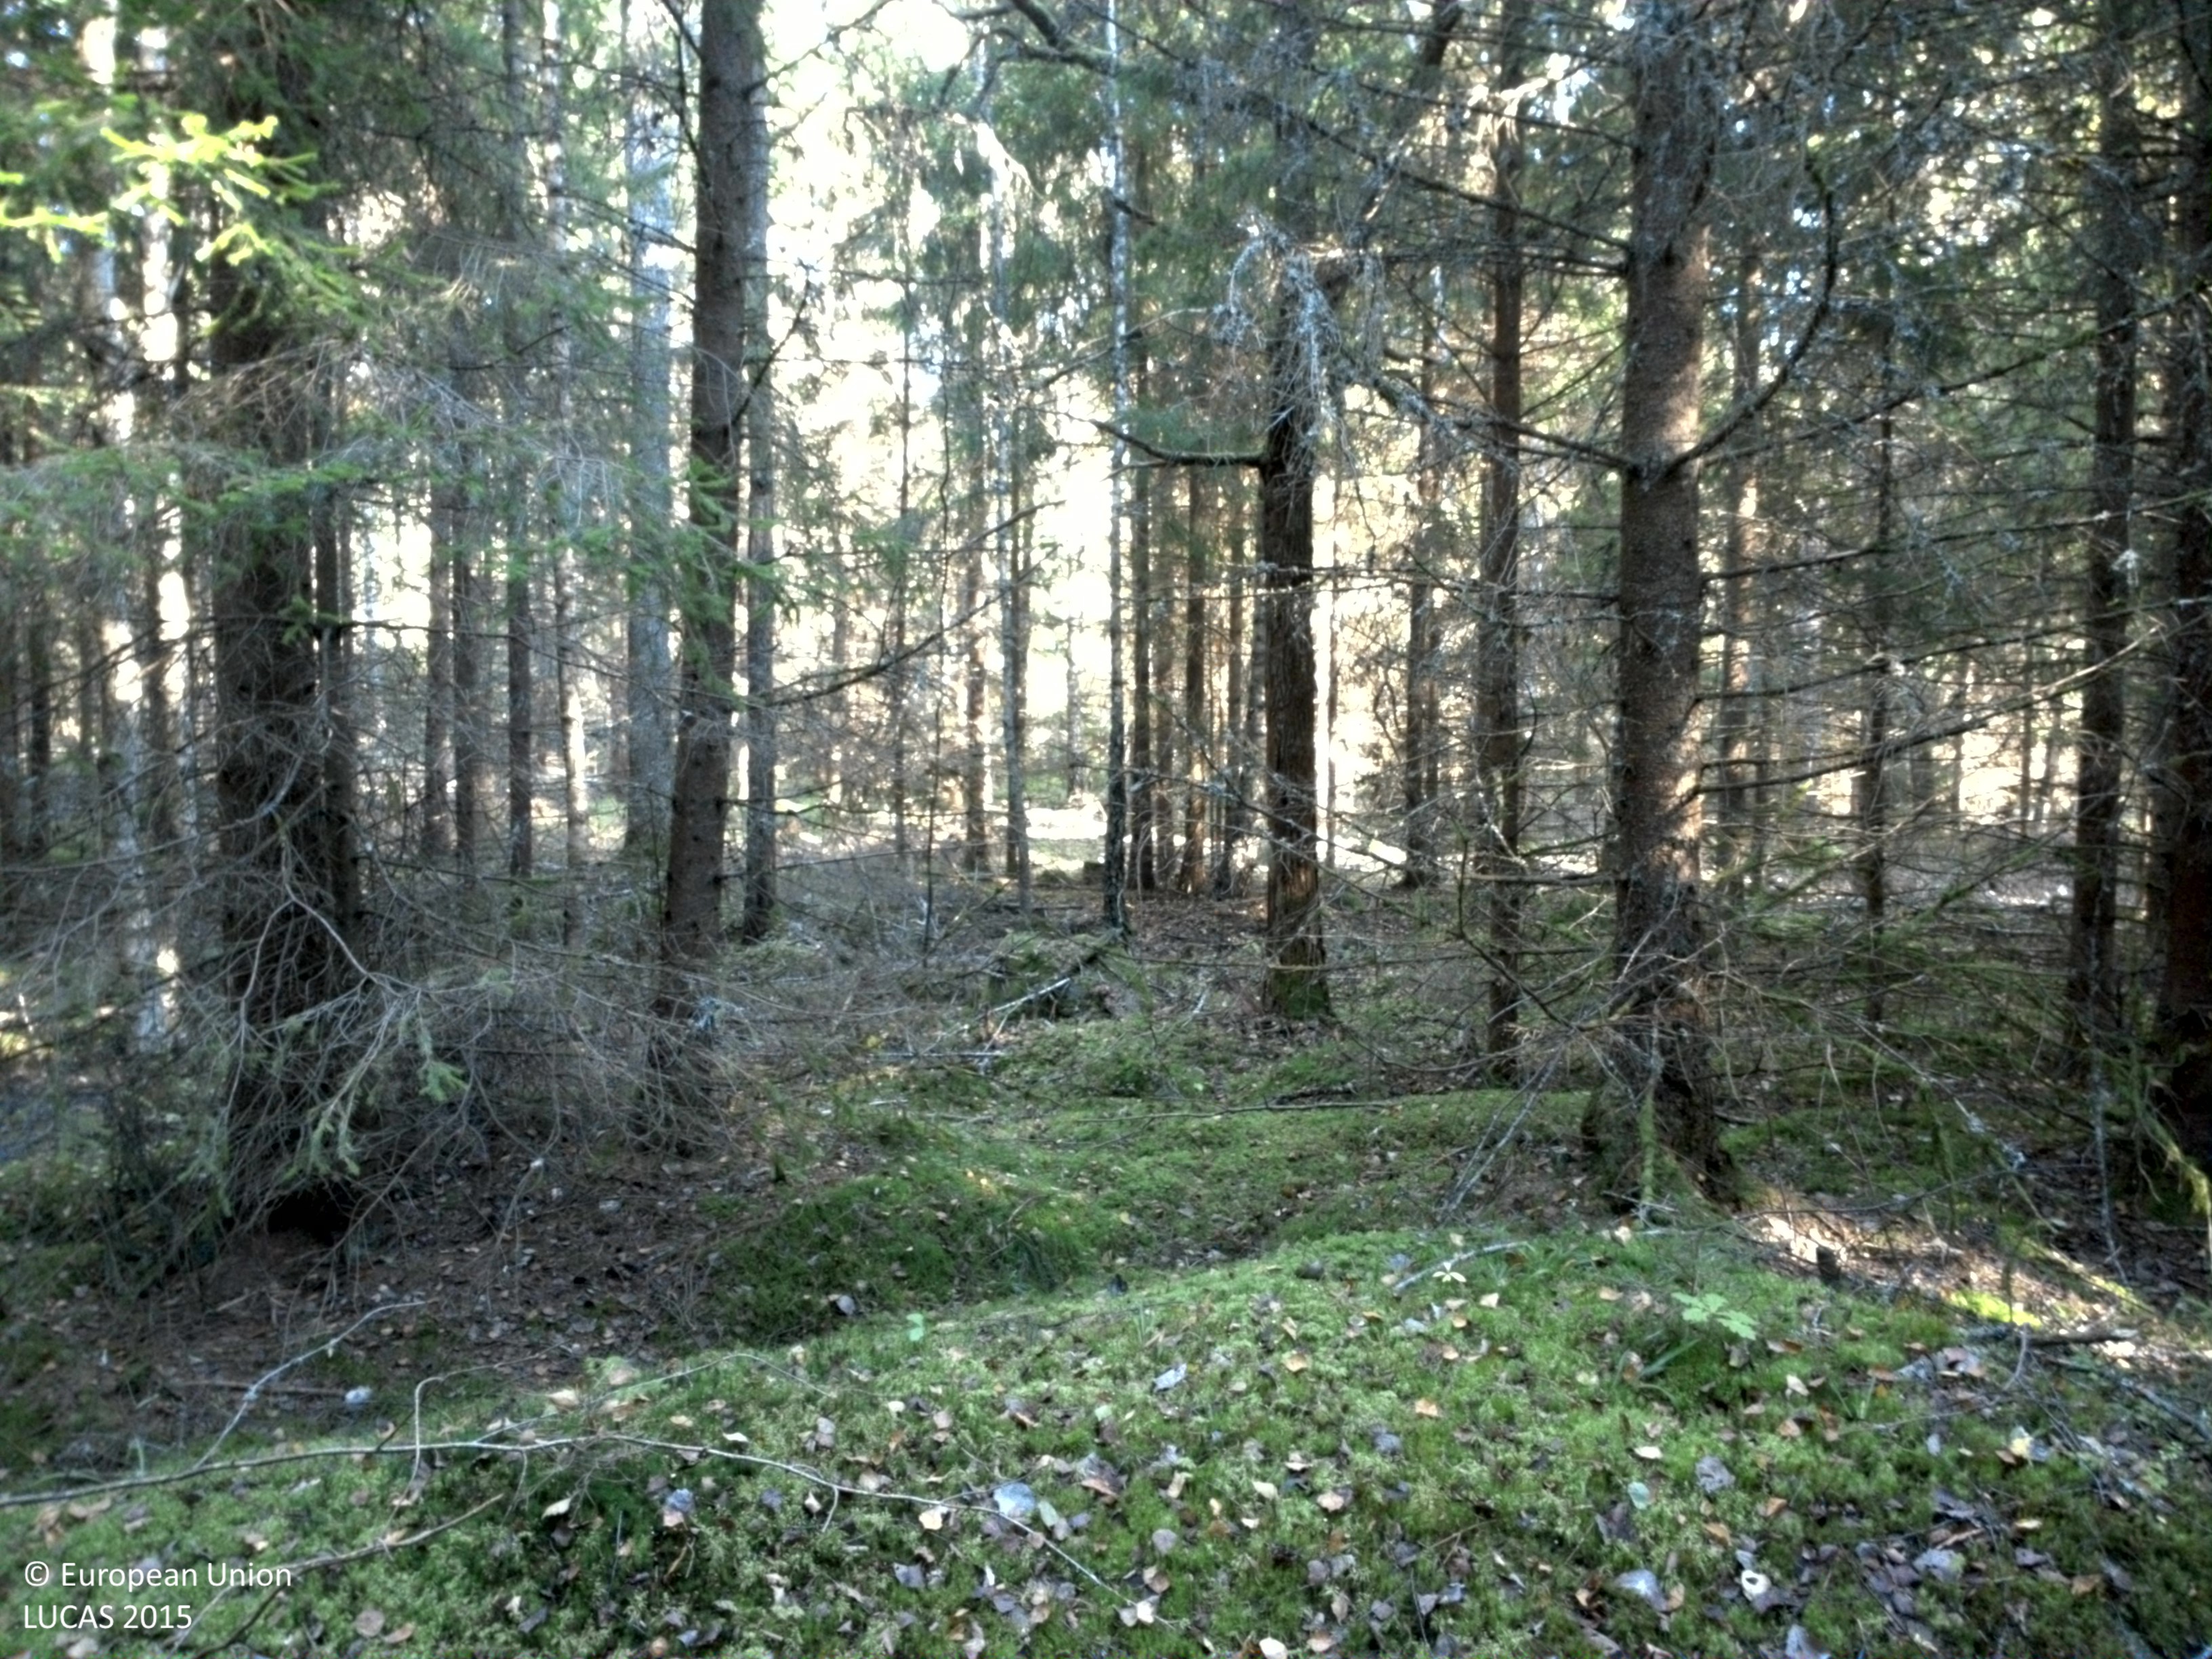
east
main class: Woodland
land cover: Spruce dominated mixed woodland
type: boreal forest
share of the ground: 10 - 25 %
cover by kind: lichens and mosses 65 %, coniferous forest trees 15 %, broadleaved forest trees 10 %, herbaceous plants 10 %
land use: Forestry
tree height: > 5 m
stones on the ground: 10 - 25 %
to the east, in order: Spruce dominated mixed woodland; Spruce dominated coniferous woodland; Spruce dominated mixed woodland; Ditches and canals; Spruce dominated mixed woodland; Spruce dominated coniferous woodland; Spruce dominated mixed woodland; Fences; Grassland without tree/shrub cover; Ditches and canals; Grassland without tree/shrub cover
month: September
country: SE
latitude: 59.0950
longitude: 14.0594
